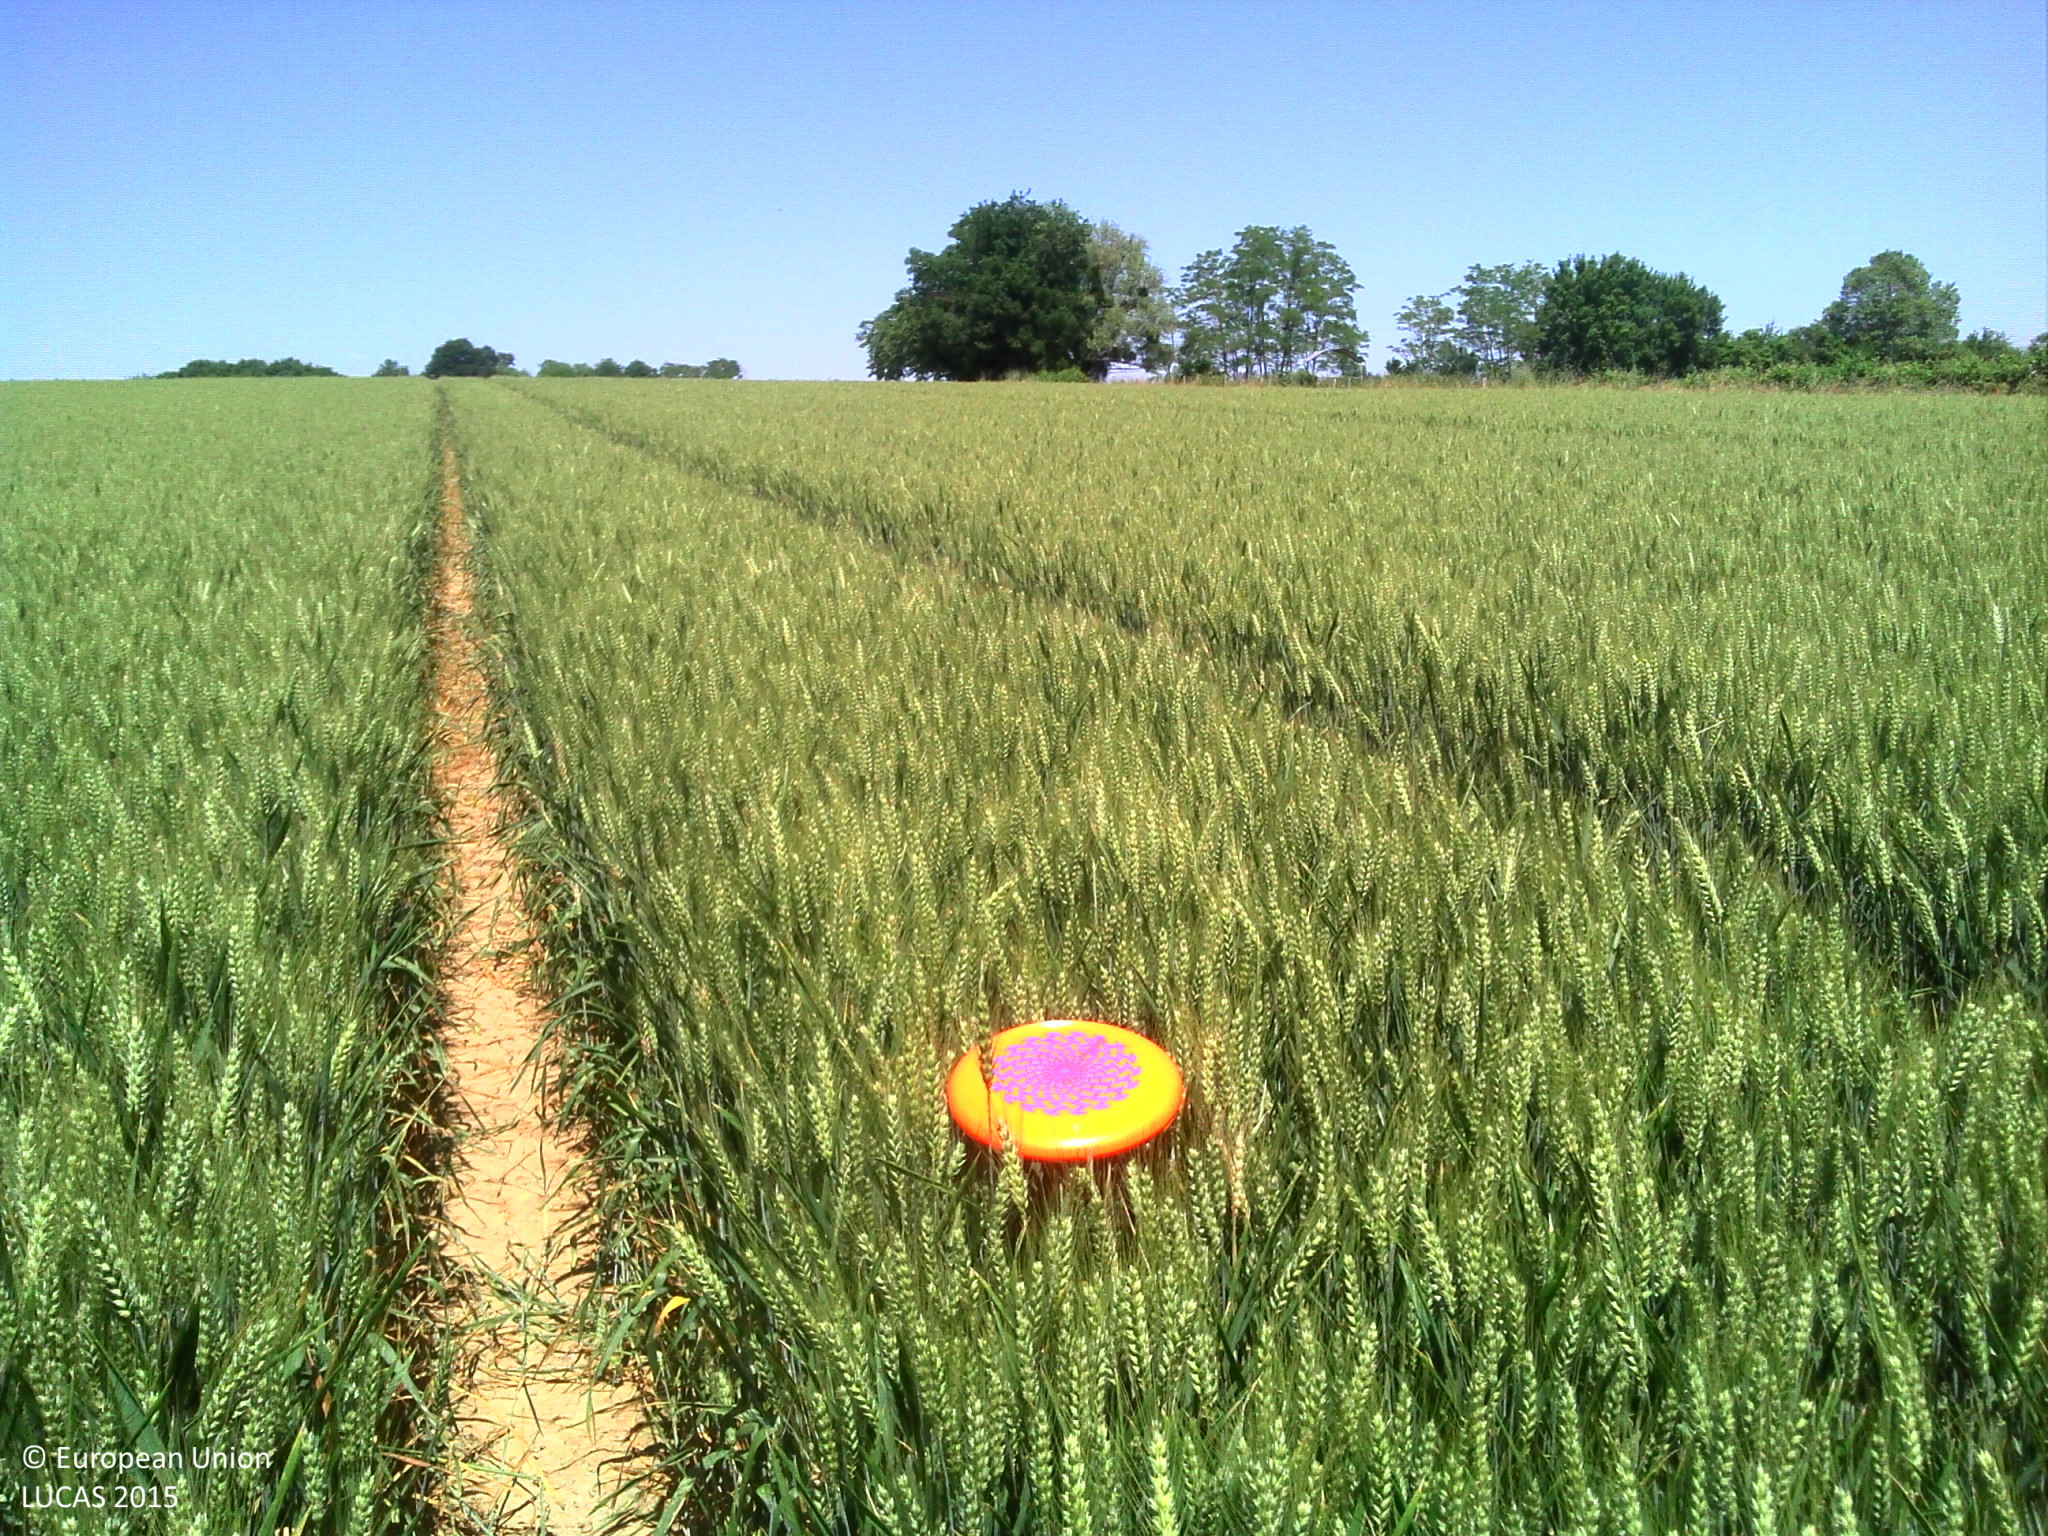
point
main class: Cropland
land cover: Common wheat
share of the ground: > 75 %
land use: Agriculture (excluding fallow land and kitchen gardens)
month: June
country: FR
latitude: 46.5006
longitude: 4.9071
